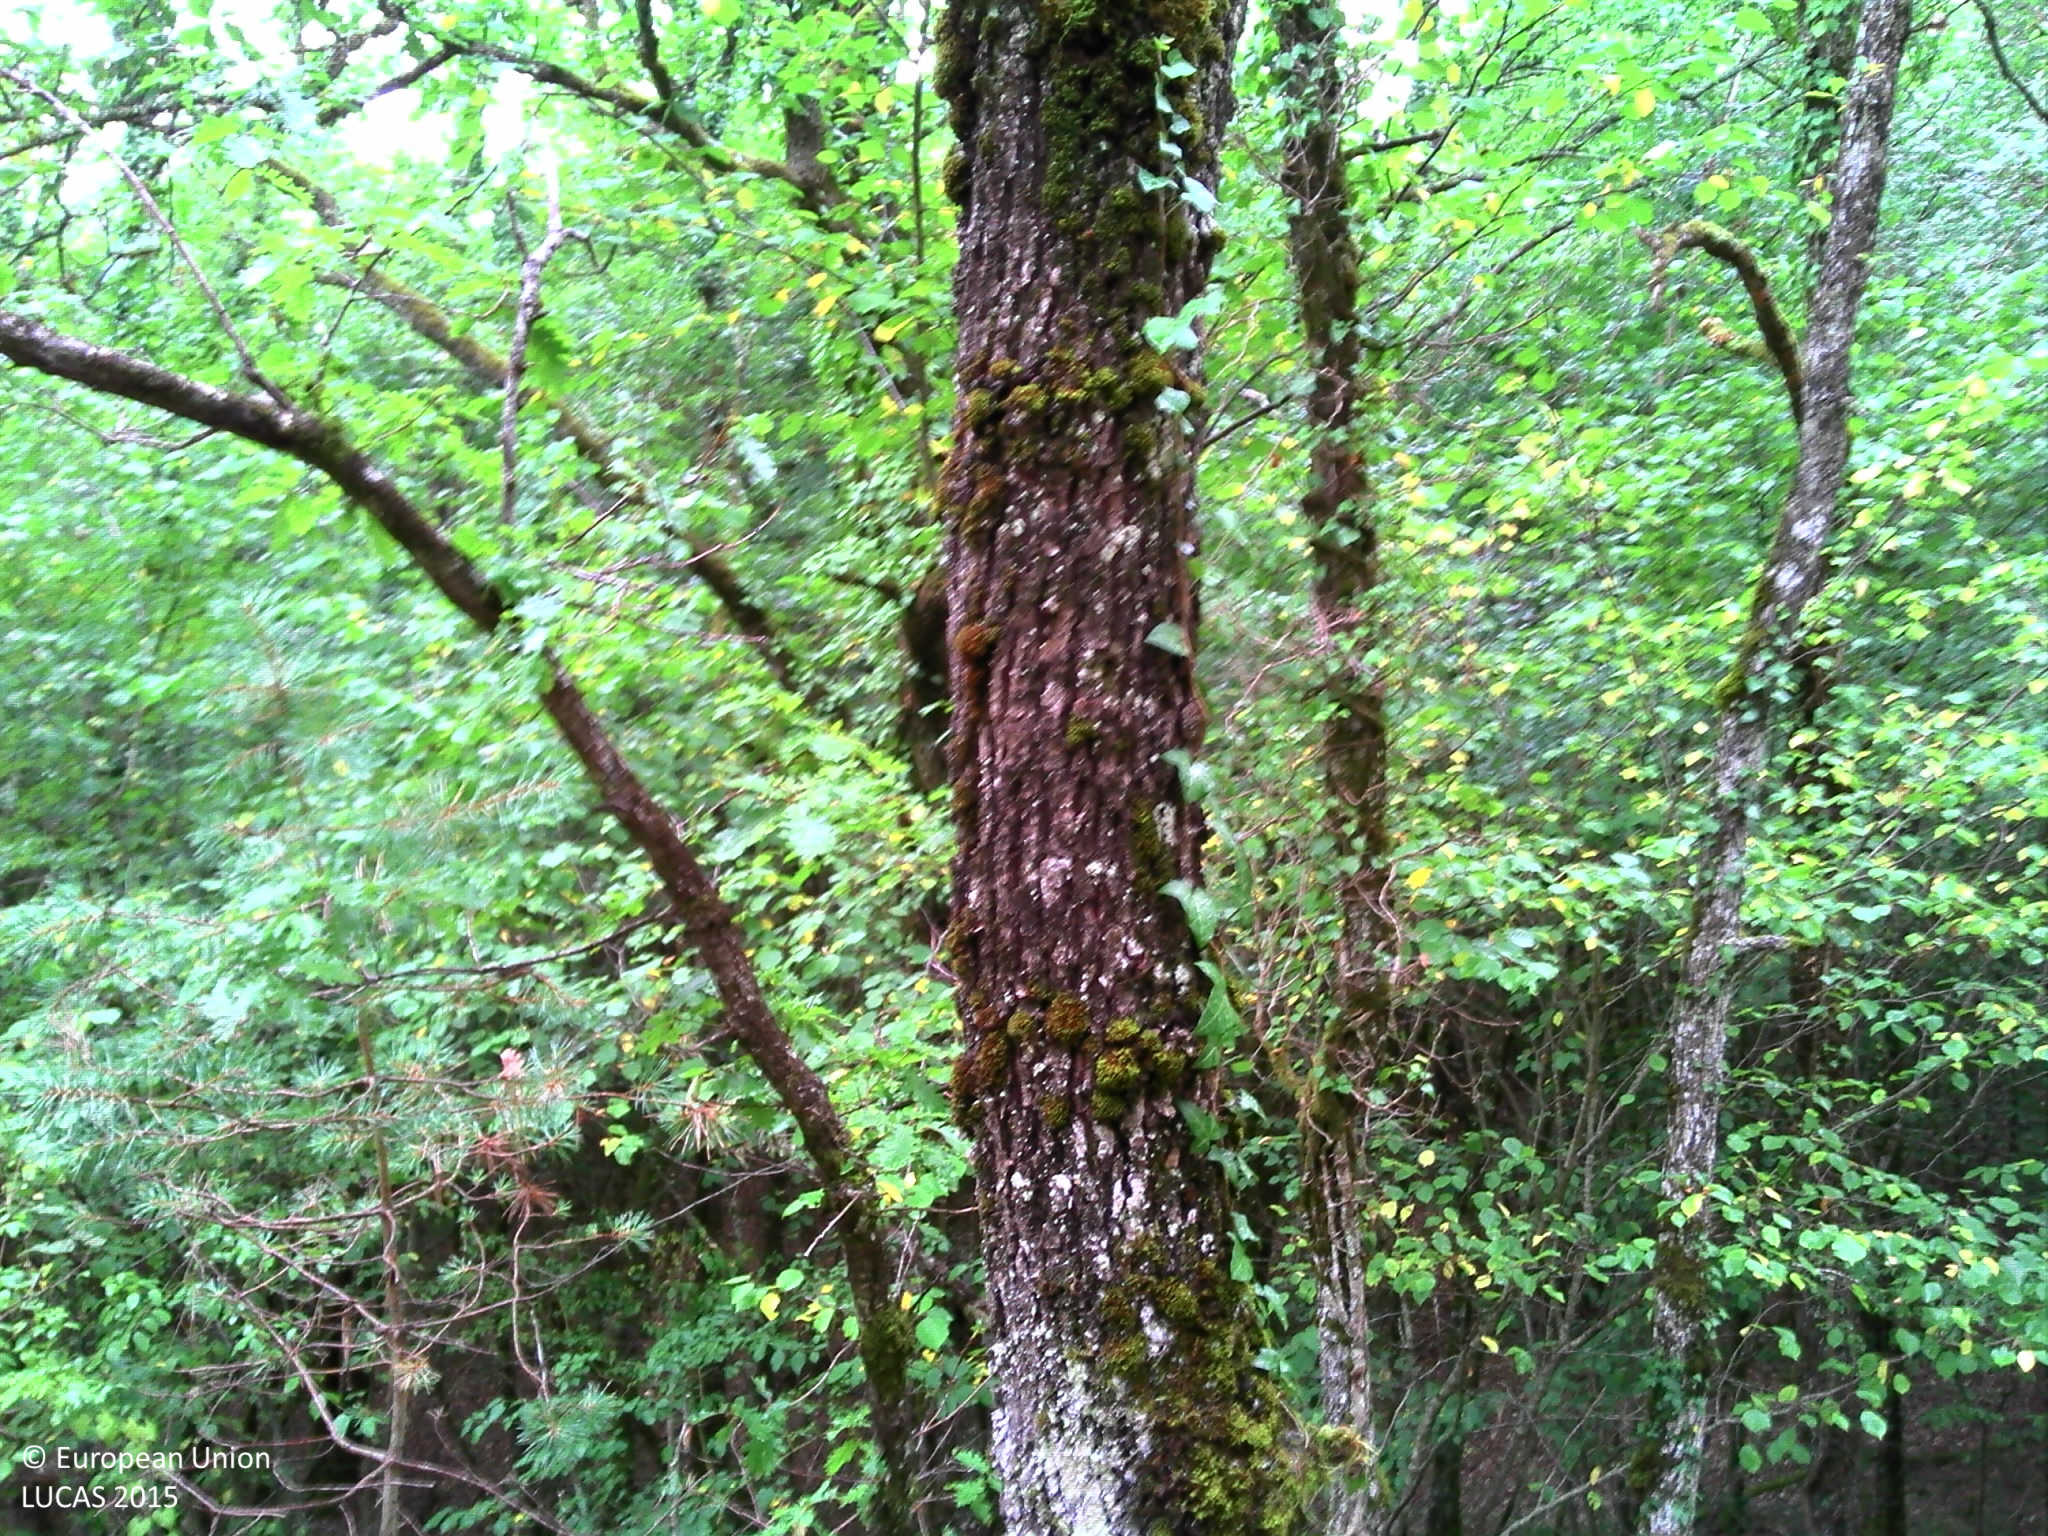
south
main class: Woodland
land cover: Pine dominated mixed woodland
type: hemiboreal forest and nemoral coniferous forest and mixed broadleaved-coniferous forest
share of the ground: > 75 %
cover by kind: broadleaved forest trees 50 %, coniferous forest trees 30 %, shrubs 10 %, herbaceous plants 10 %
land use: Forestry
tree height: > 5 m
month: July
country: FR
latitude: 44.9012
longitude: 0.7852
